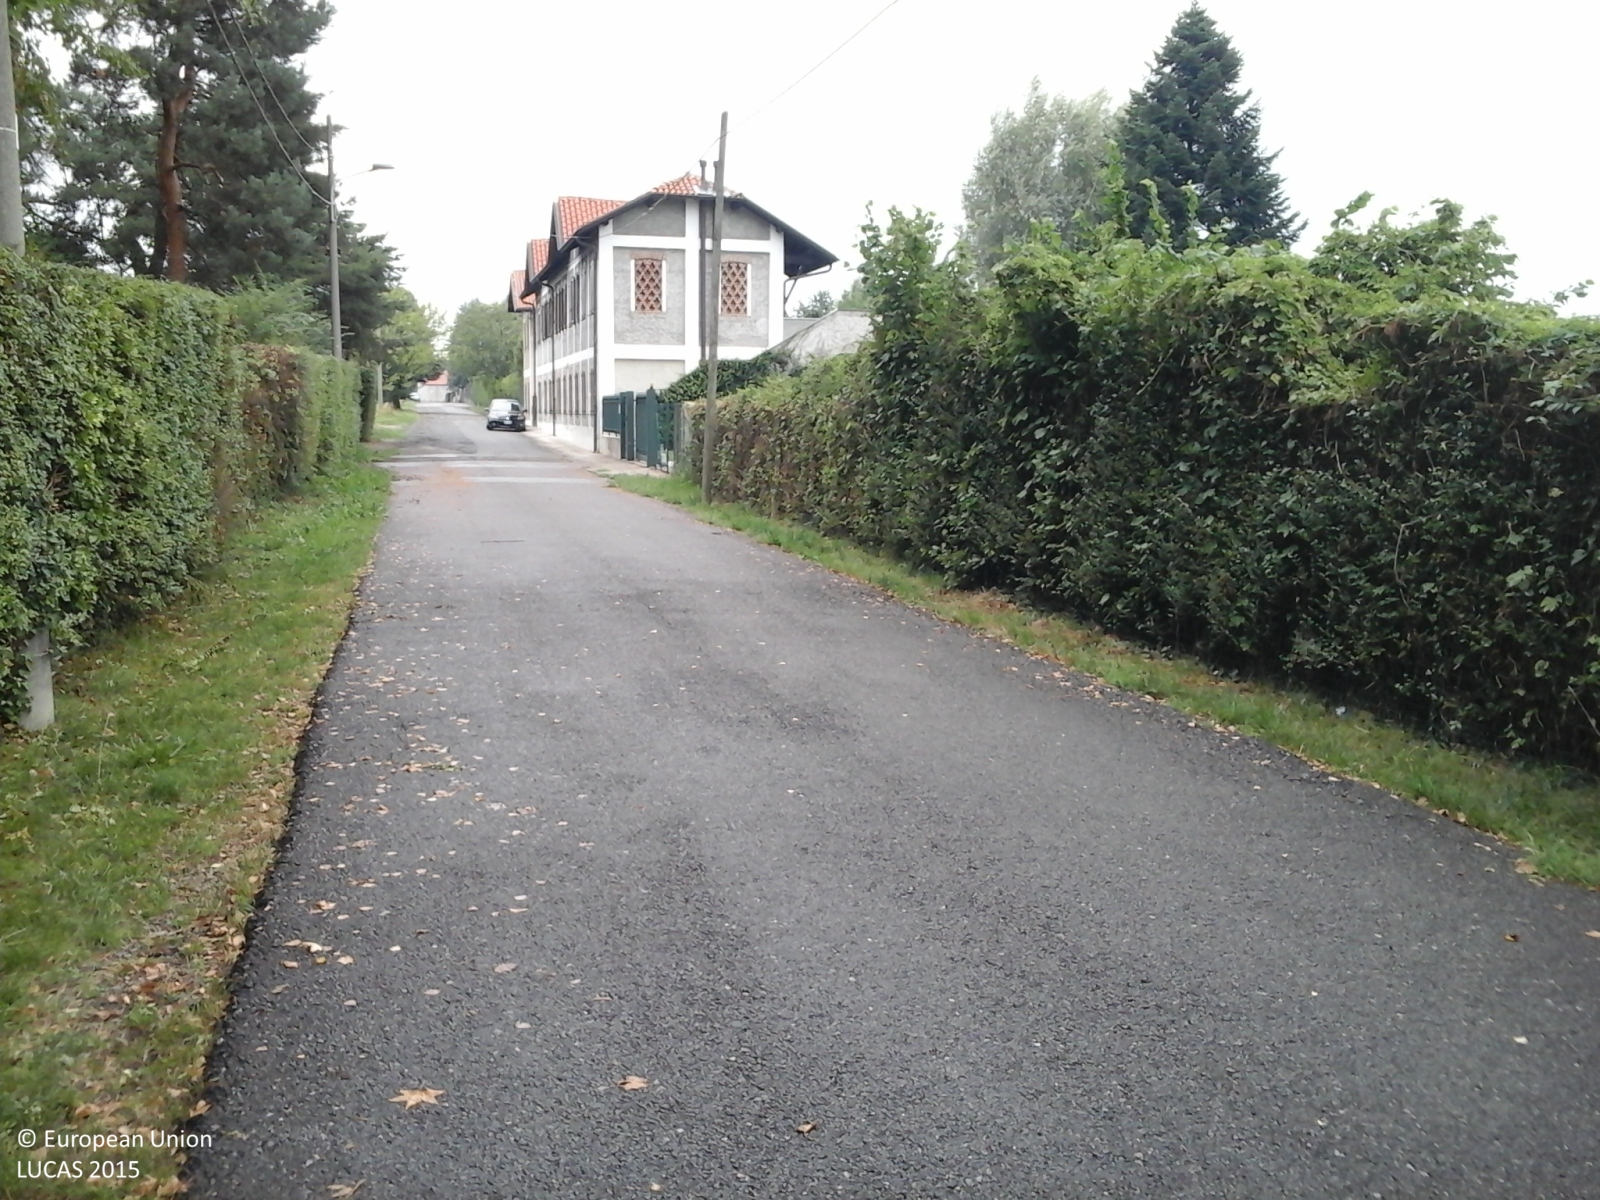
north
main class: Grassland
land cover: Grassland without tree/shrub cover
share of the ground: > 75 %
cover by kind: herbaceous plants 100 %
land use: Residential
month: August
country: IT
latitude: 45.6629
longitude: 9.1158
